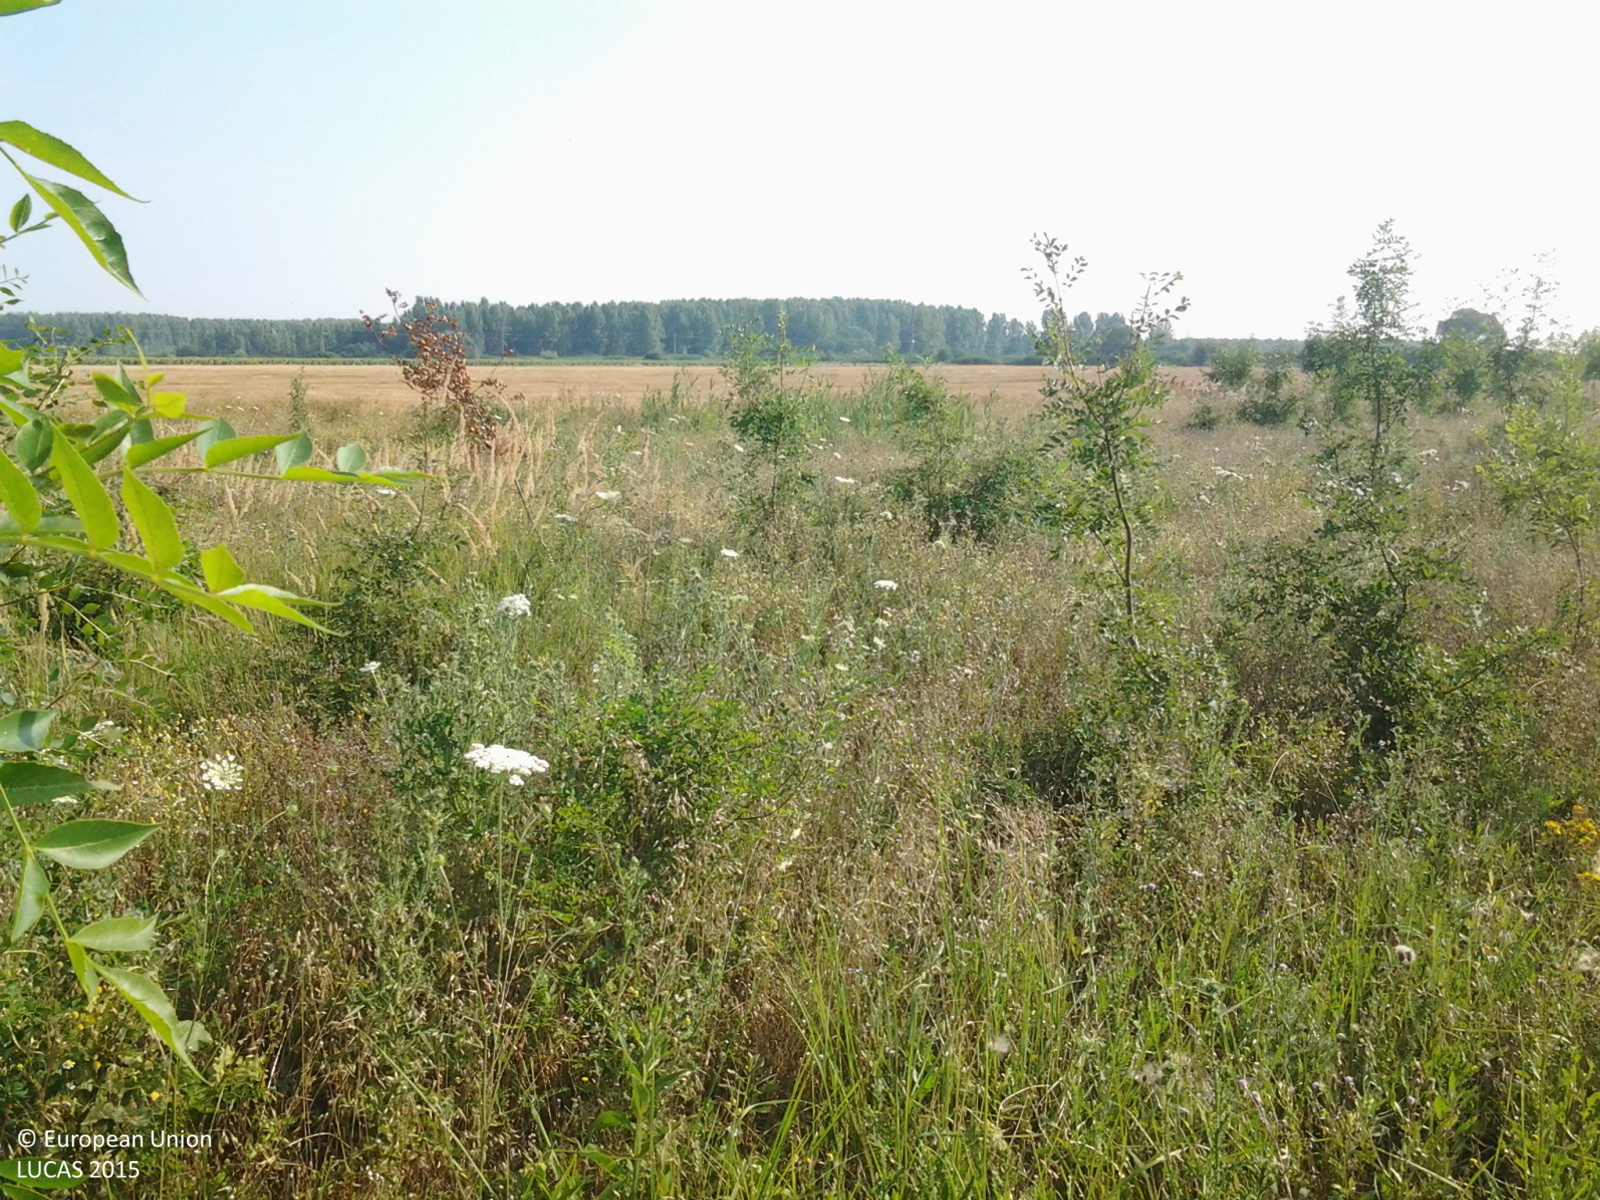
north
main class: Woodland
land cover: Broadleaved woodland
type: mesophytic deciduous forest
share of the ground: > 75 %
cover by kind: broadleaved forest trees 75 %, herbaceous plants 20 %, shrubs 5 %
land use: Forestry
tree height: < 5 m
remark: Nursery
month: July
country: HU
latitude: 46.7561
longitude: 21.4148
